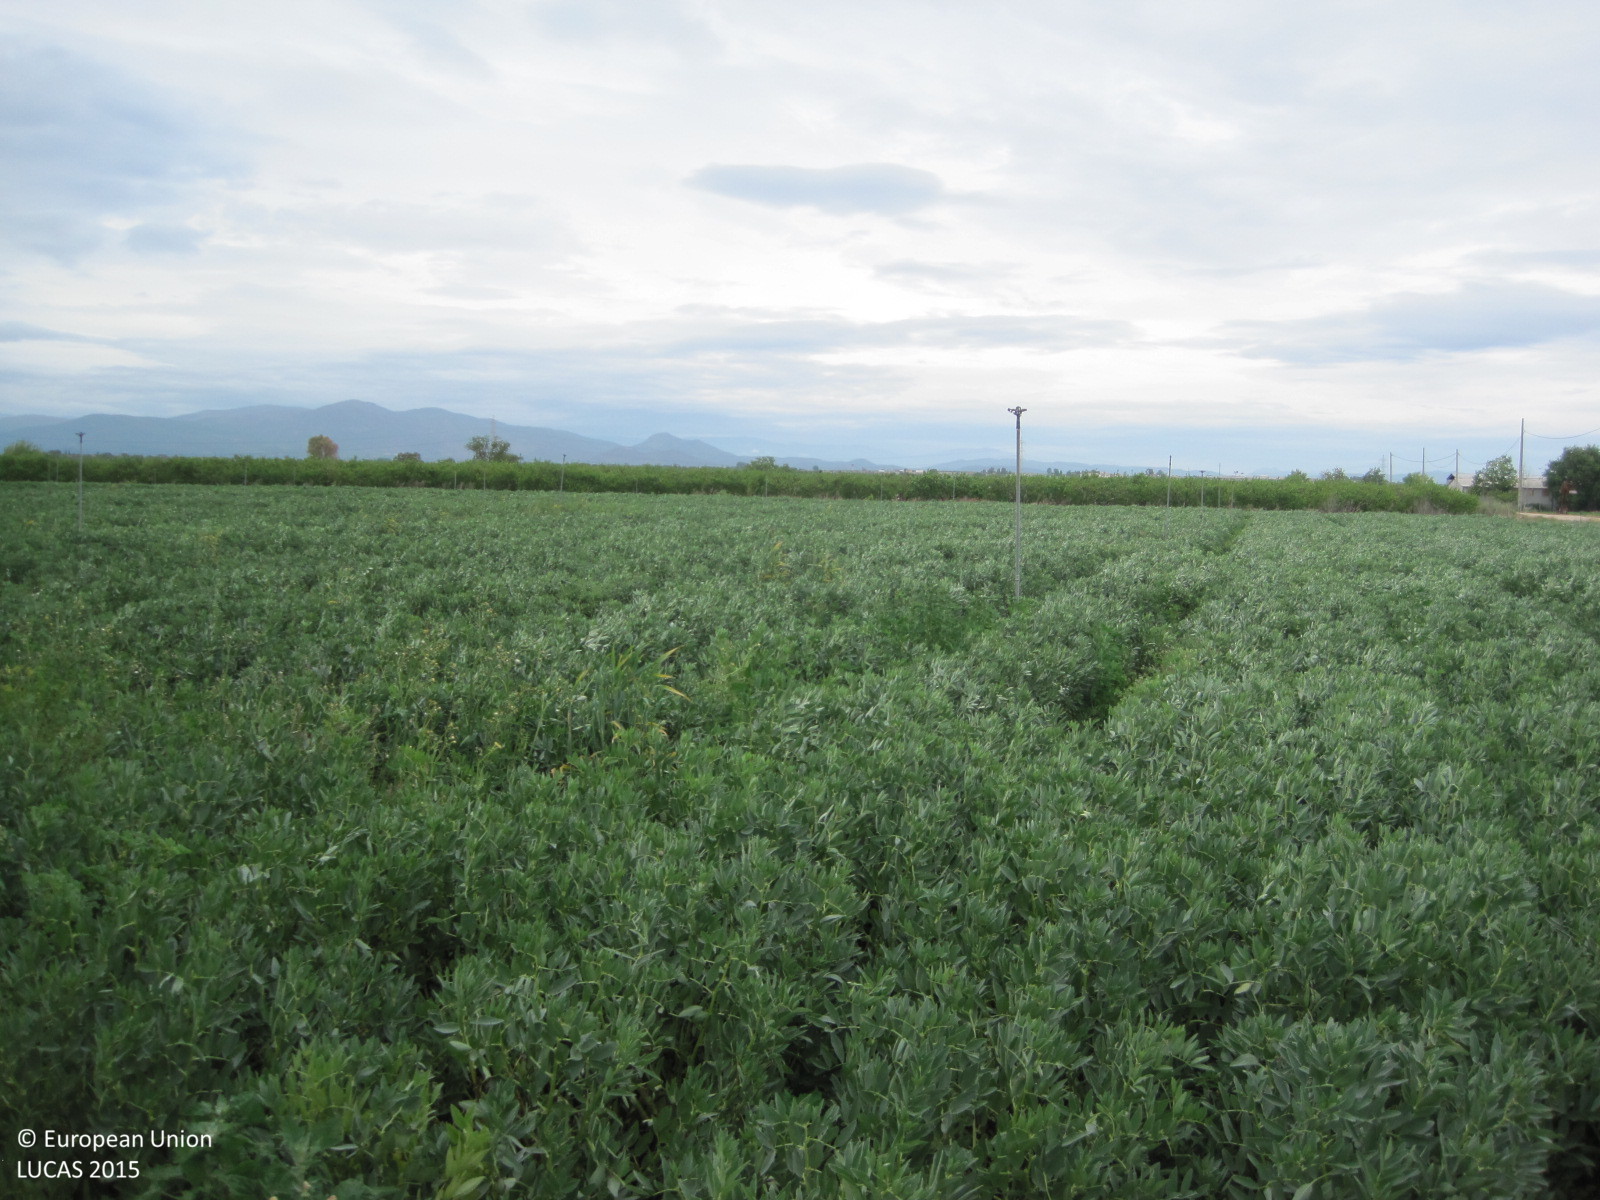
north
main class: Cropland
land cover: Dry pulses
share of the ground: > 75 %
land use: Agriculture (excluding fallow land and kitchen gardens)
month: May
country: ES
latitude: 39.9588
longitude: -4.7138
